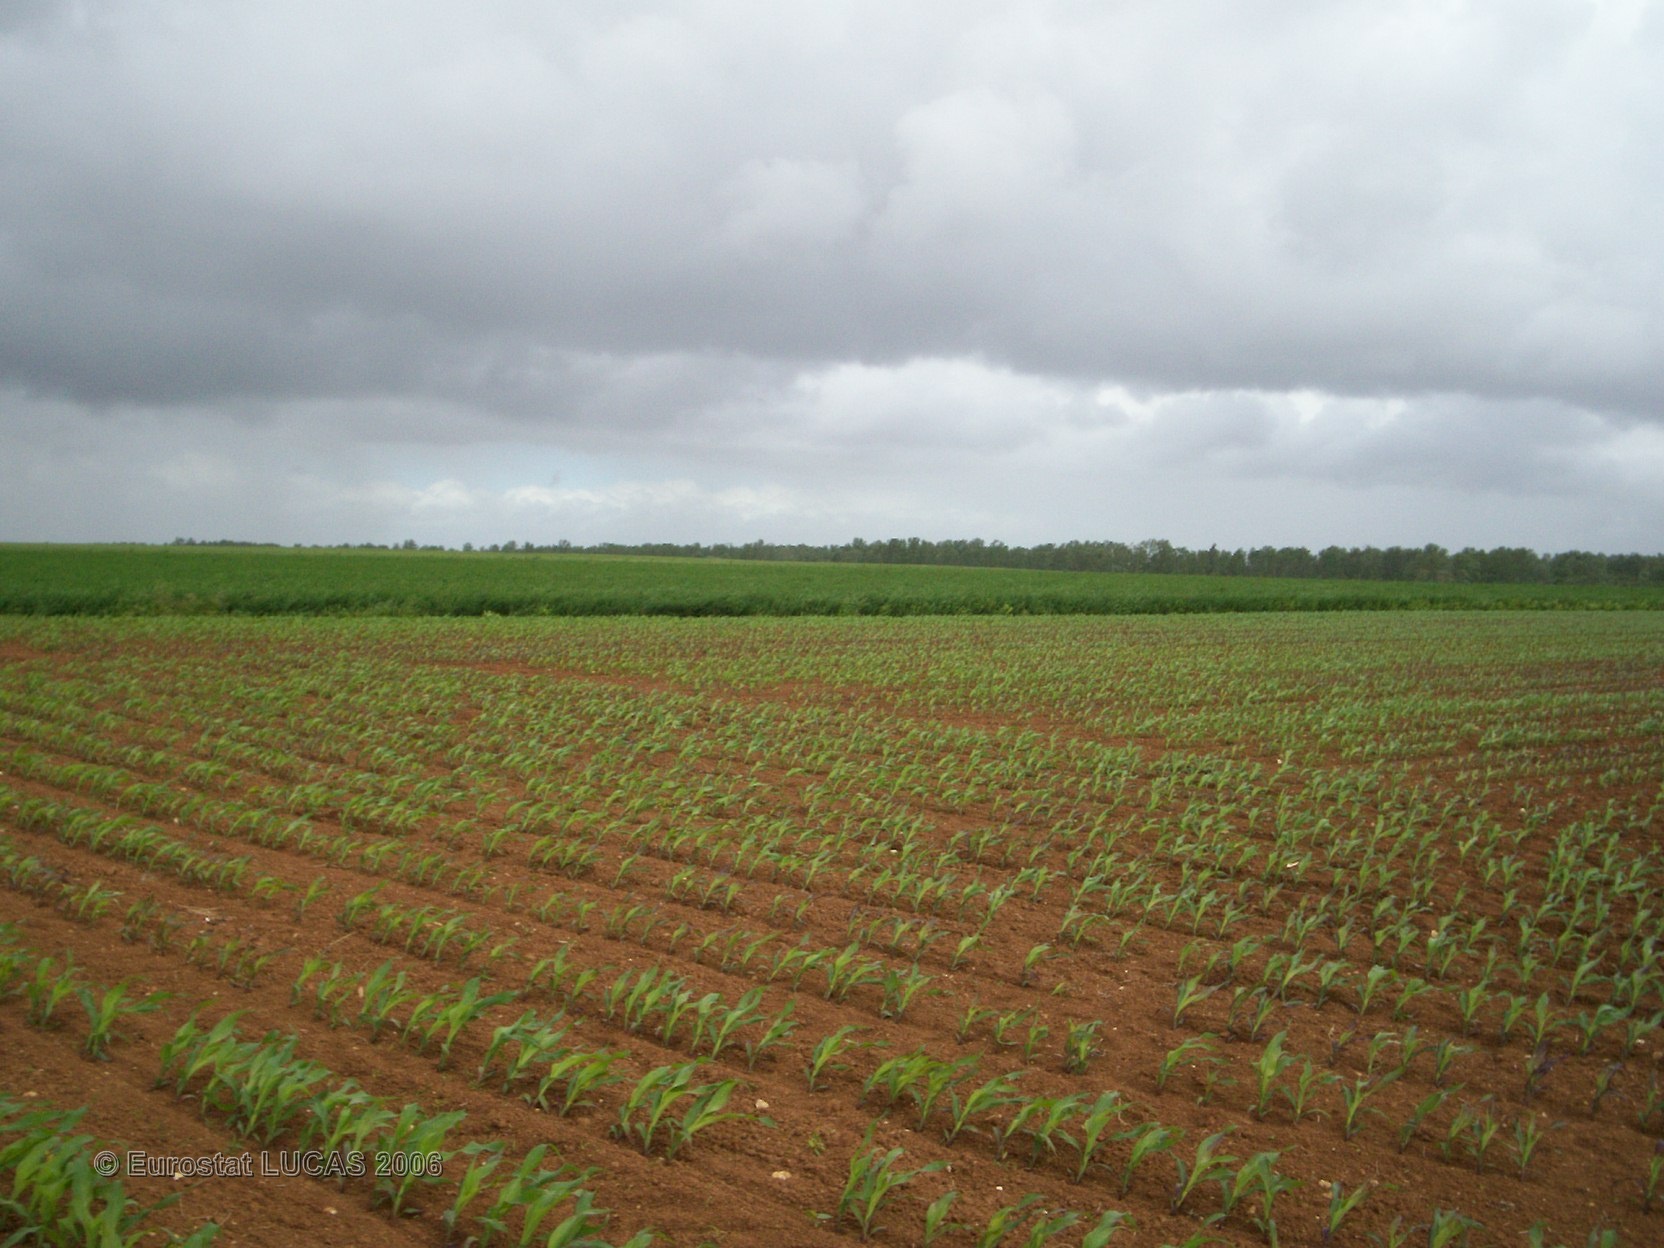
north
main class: Cropland
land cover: Maize
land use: Agriculture (excluding fallow land and kitchen gardens)
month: May
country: FR
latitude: 46.4009
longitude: -0.8118
